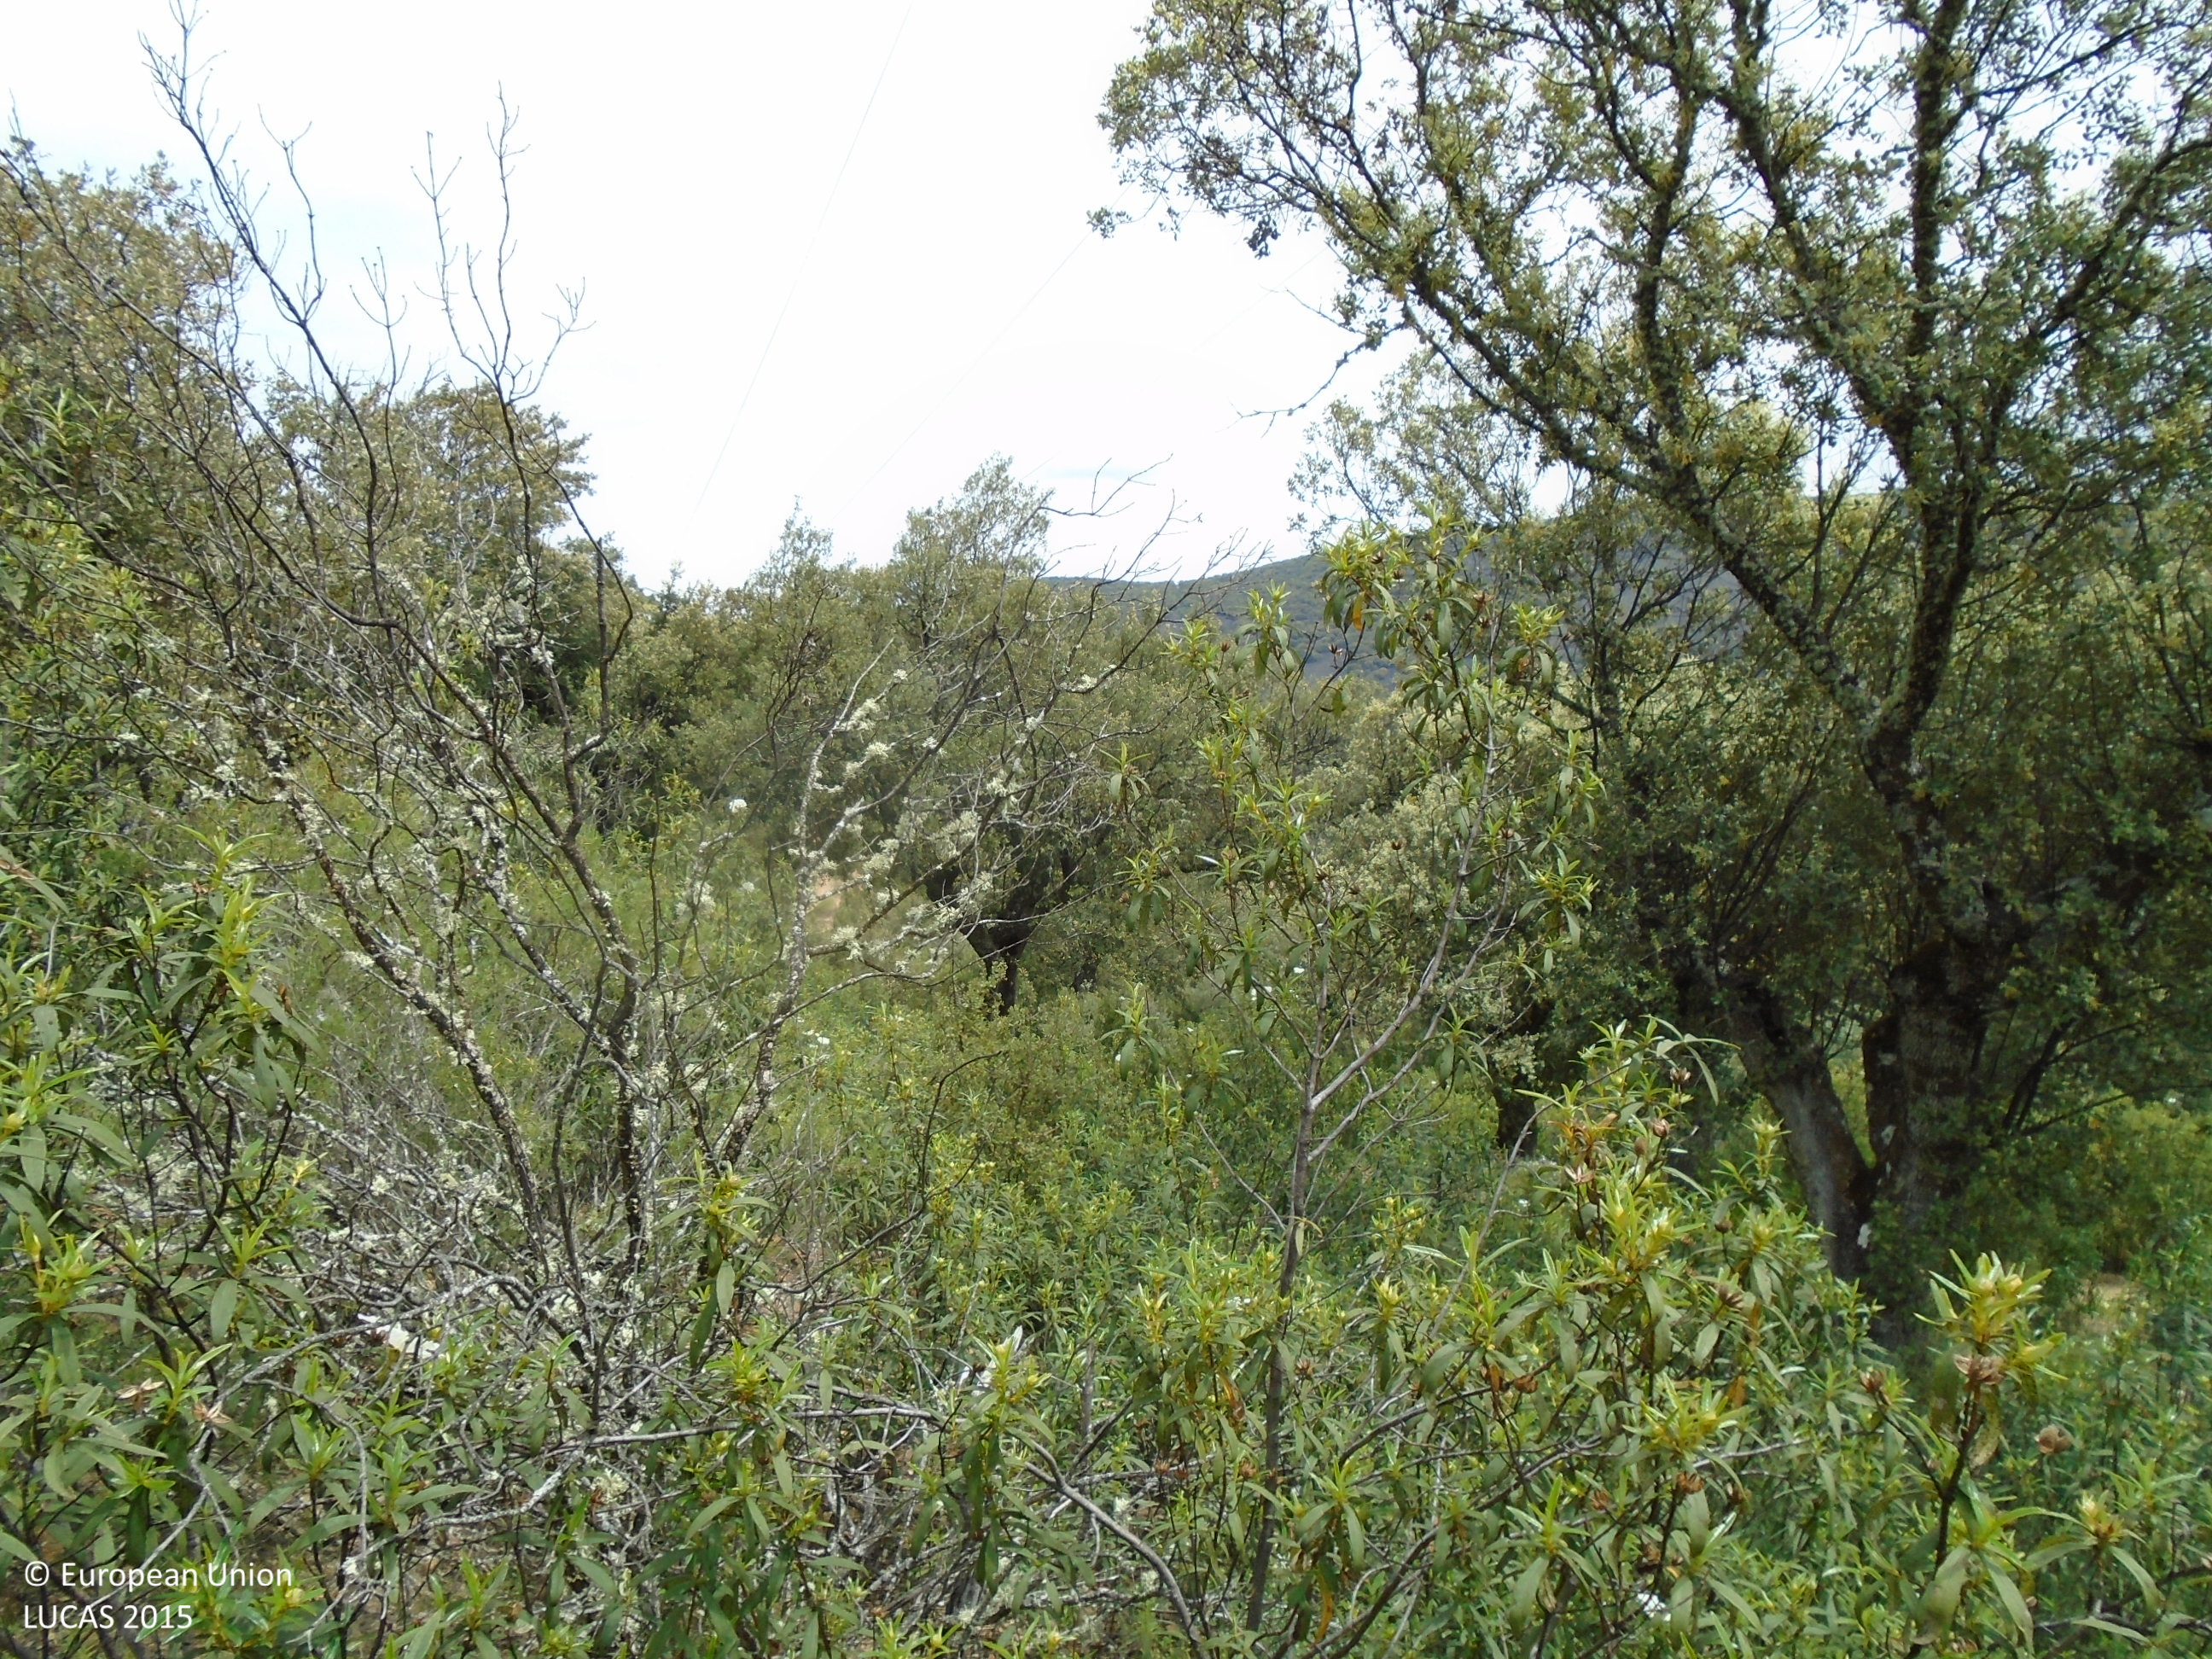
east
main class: Woodland
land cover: Broadleaved woodland
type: broadleaved evergreen forest
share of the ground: > 75 %
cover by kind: broadleaved forest trees 85 %, shrubs 10 %, consolidated bare surface 5 %
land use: Semi-natural and natural areas not in use
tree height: > 5 m
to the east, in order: Broadleaved woodland; Shrubland with sparse tree cover; Tracks; Abandoned hedges; Fences; Grassland with sparse tree/shrub cover; Fences; Shrubland with sparse tree cover
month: May
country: ES
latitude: 39.6189
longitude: -4.8959
